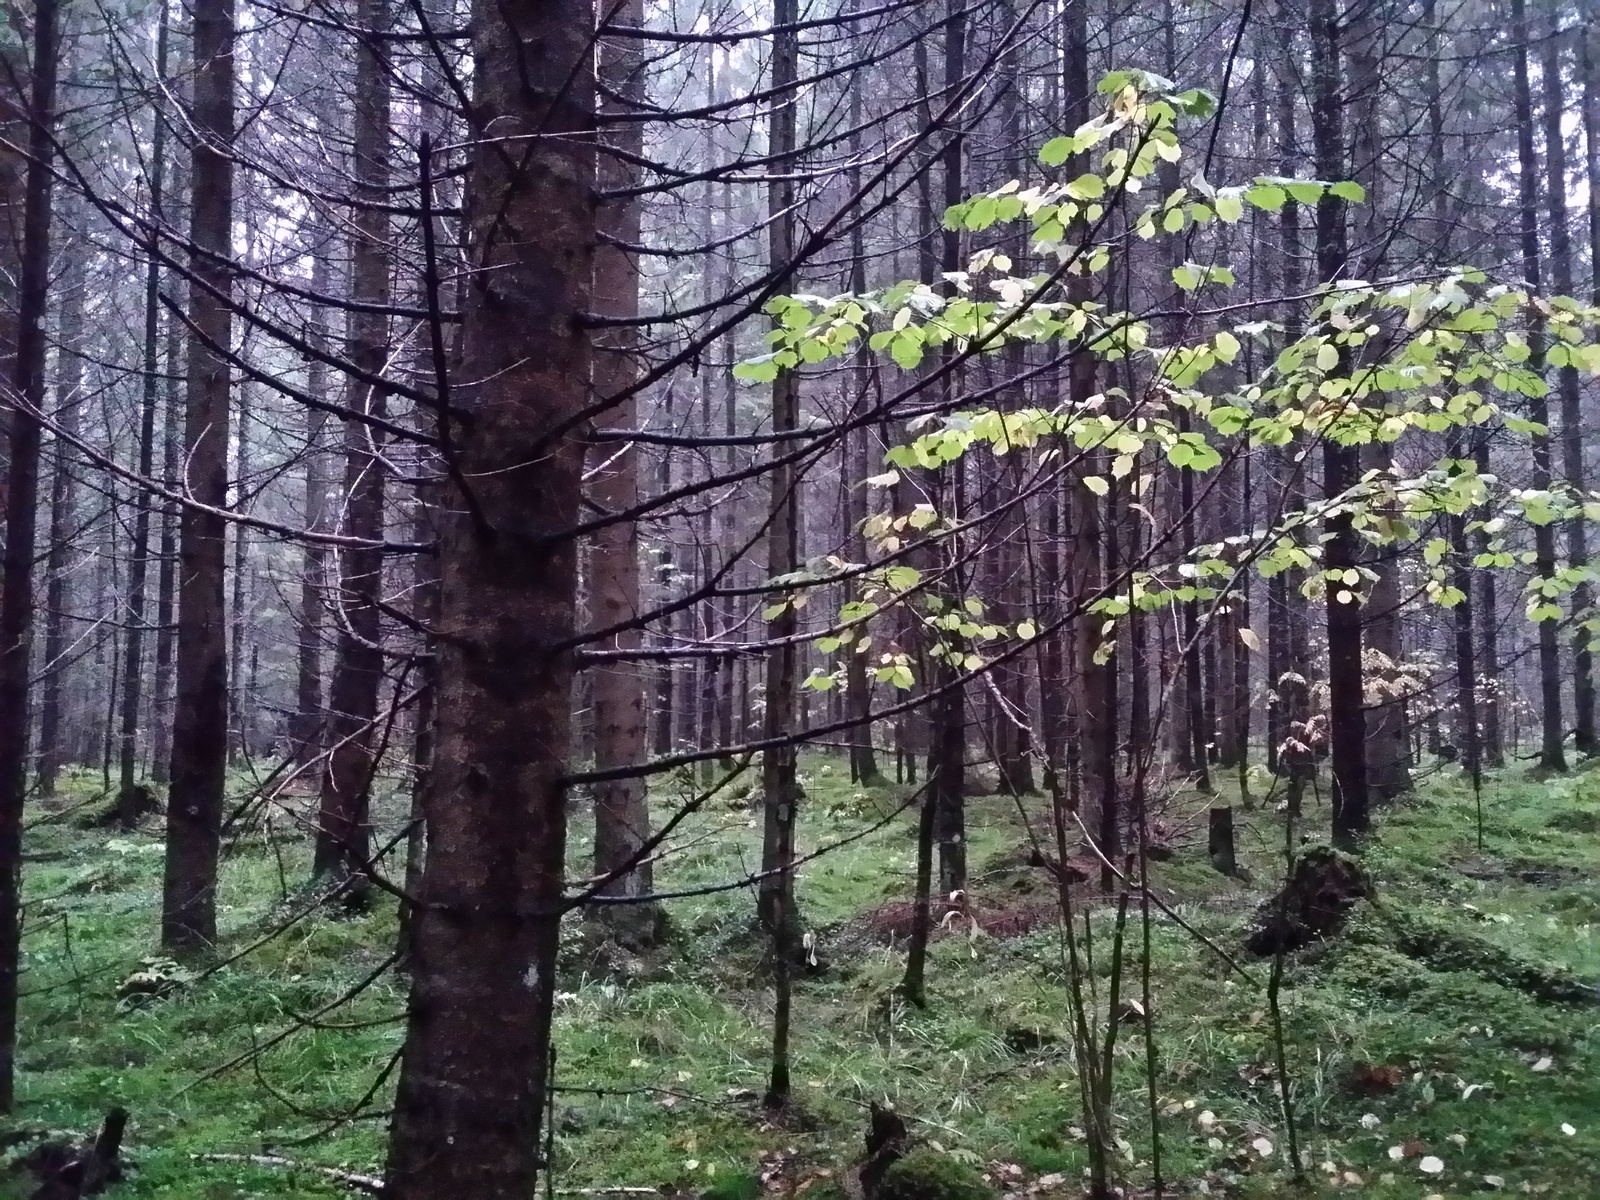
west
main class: Woodland
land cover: Spruce dominated coniferous woodland
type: hemiboreal forest and nemoral coniferous forest and mixed broadleaved-coniferous forest
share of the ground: > 75 %
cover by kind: coniferous forest trees 75 %, broadleaved forest trees 15 %, herbaceous plants 5 %, lichens and mosses 5 %
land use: Forestry
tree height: > 5 m
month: September
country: LV
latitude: 57.4597
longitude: 27.3894
